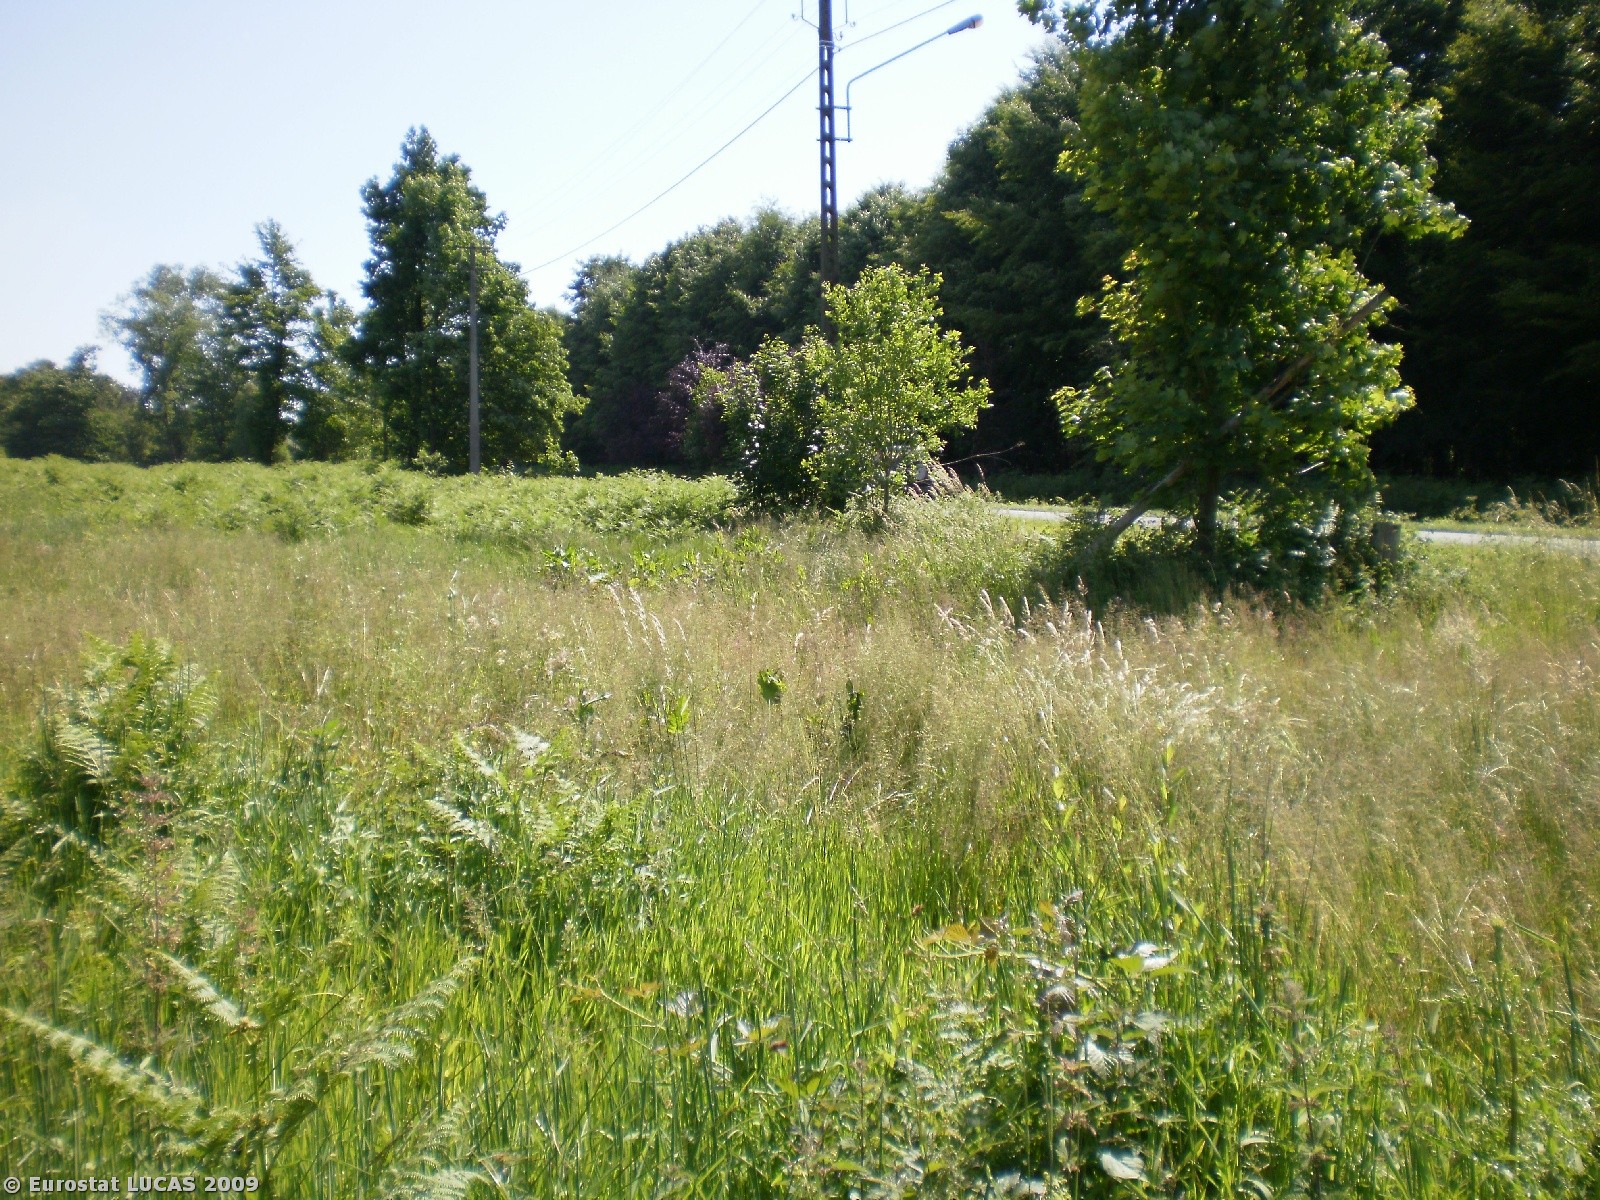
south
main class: Grassland
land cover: Grassland with sparse tree/shrub cover
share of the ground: > 75 %
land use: Unused
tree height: > 5 m
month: June
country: BE
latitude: 50.5042
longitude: 3.8321
